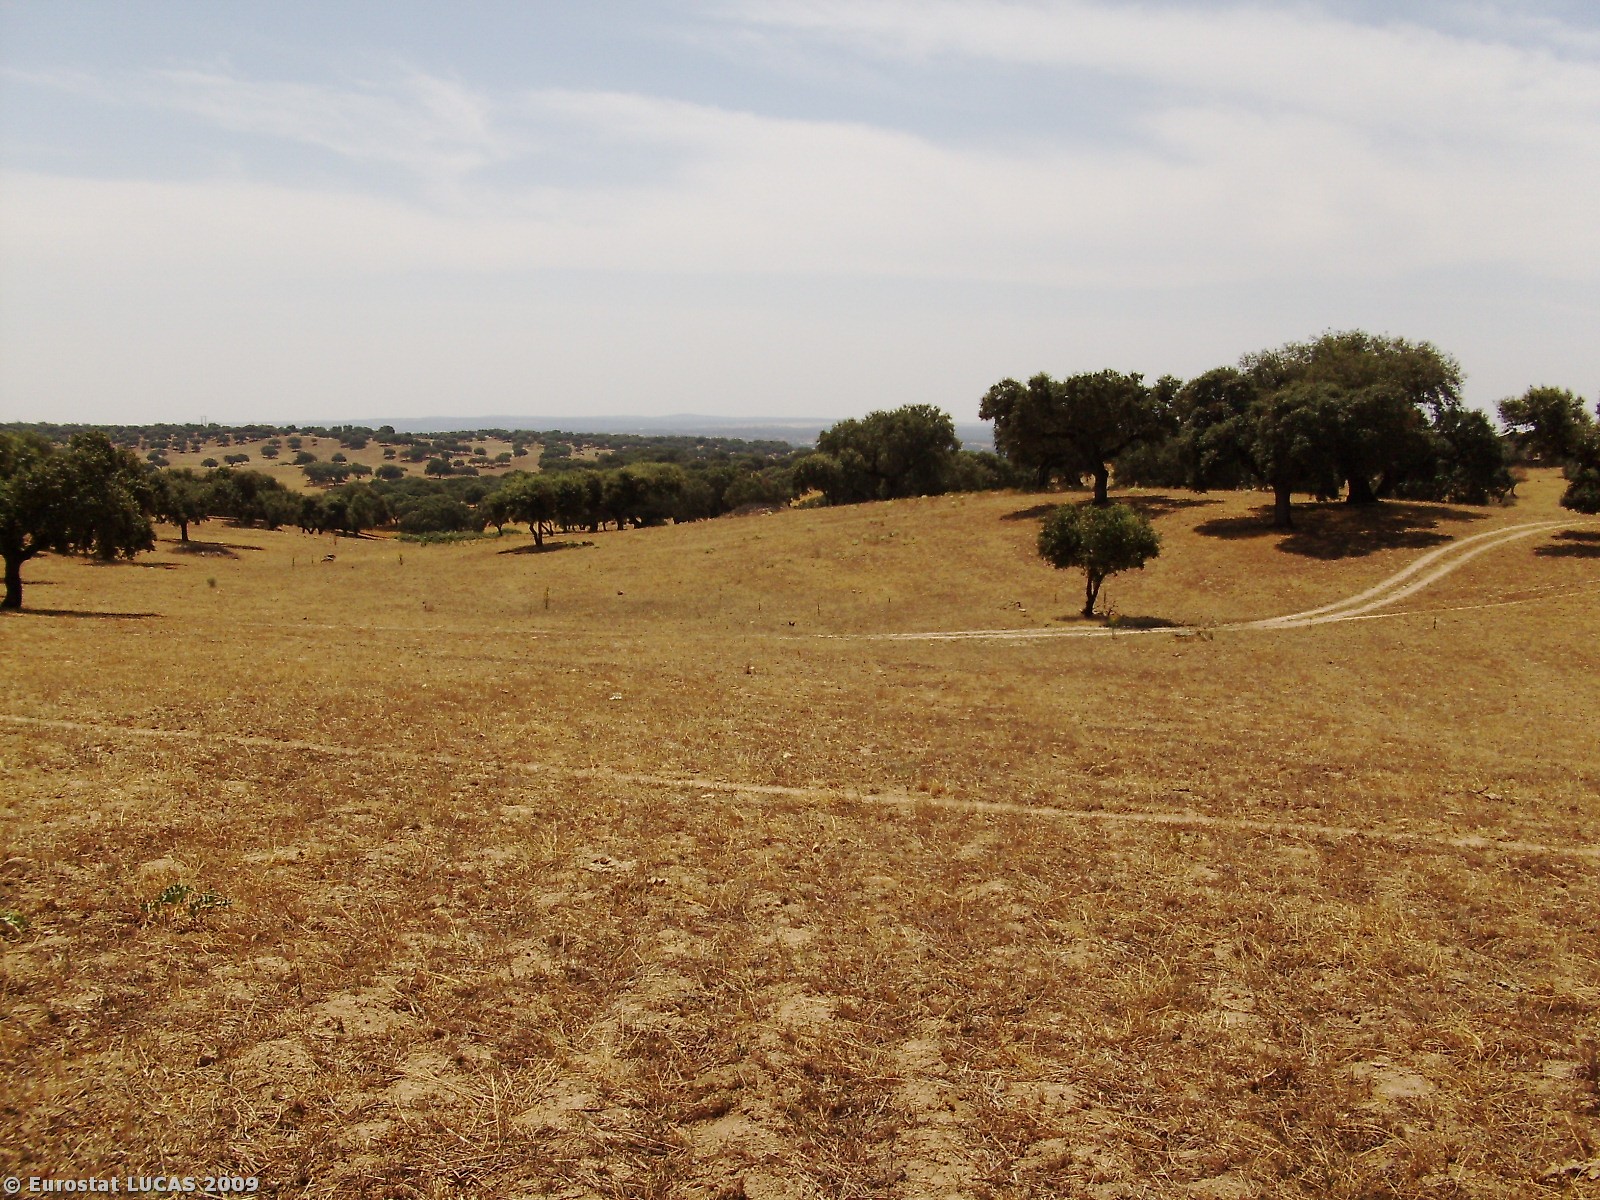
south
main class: Grassland
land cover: Grassland without tree/shrub cover
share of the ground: > 75 %
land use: Agriculture (excluding fallow land and kitchen gardens)
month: June
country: PT
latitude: 39.0873
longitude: -7.2951
